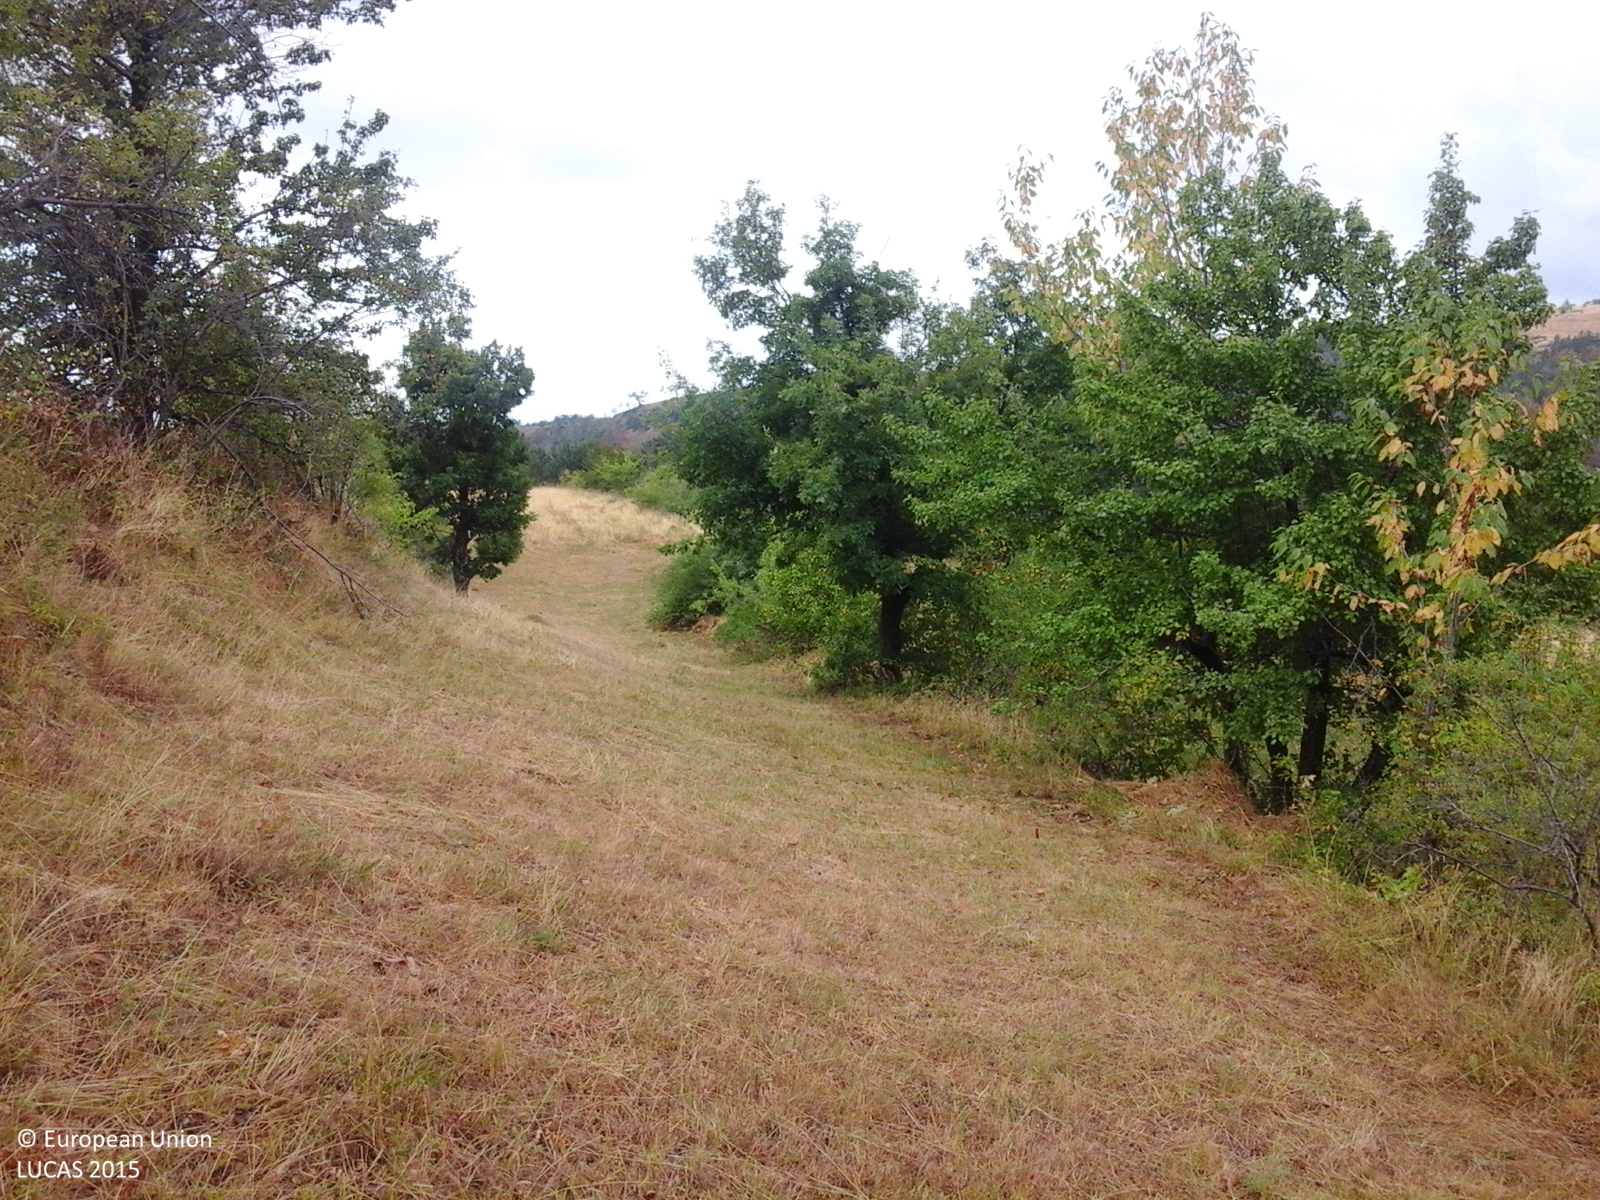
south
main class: Grassland
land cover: Grassland with sparse tree/shrub cover
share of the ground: > 75 %
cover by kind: herbaceous plants 85 %, shrubs 10 %, broadleaved forest trees 5 %
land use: Agriculture (excluding fallow land and kitchen gardens)
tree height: > 5 m
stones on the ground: < 10 %
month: August
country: RO
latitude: 44.7952
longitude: 22.6456
